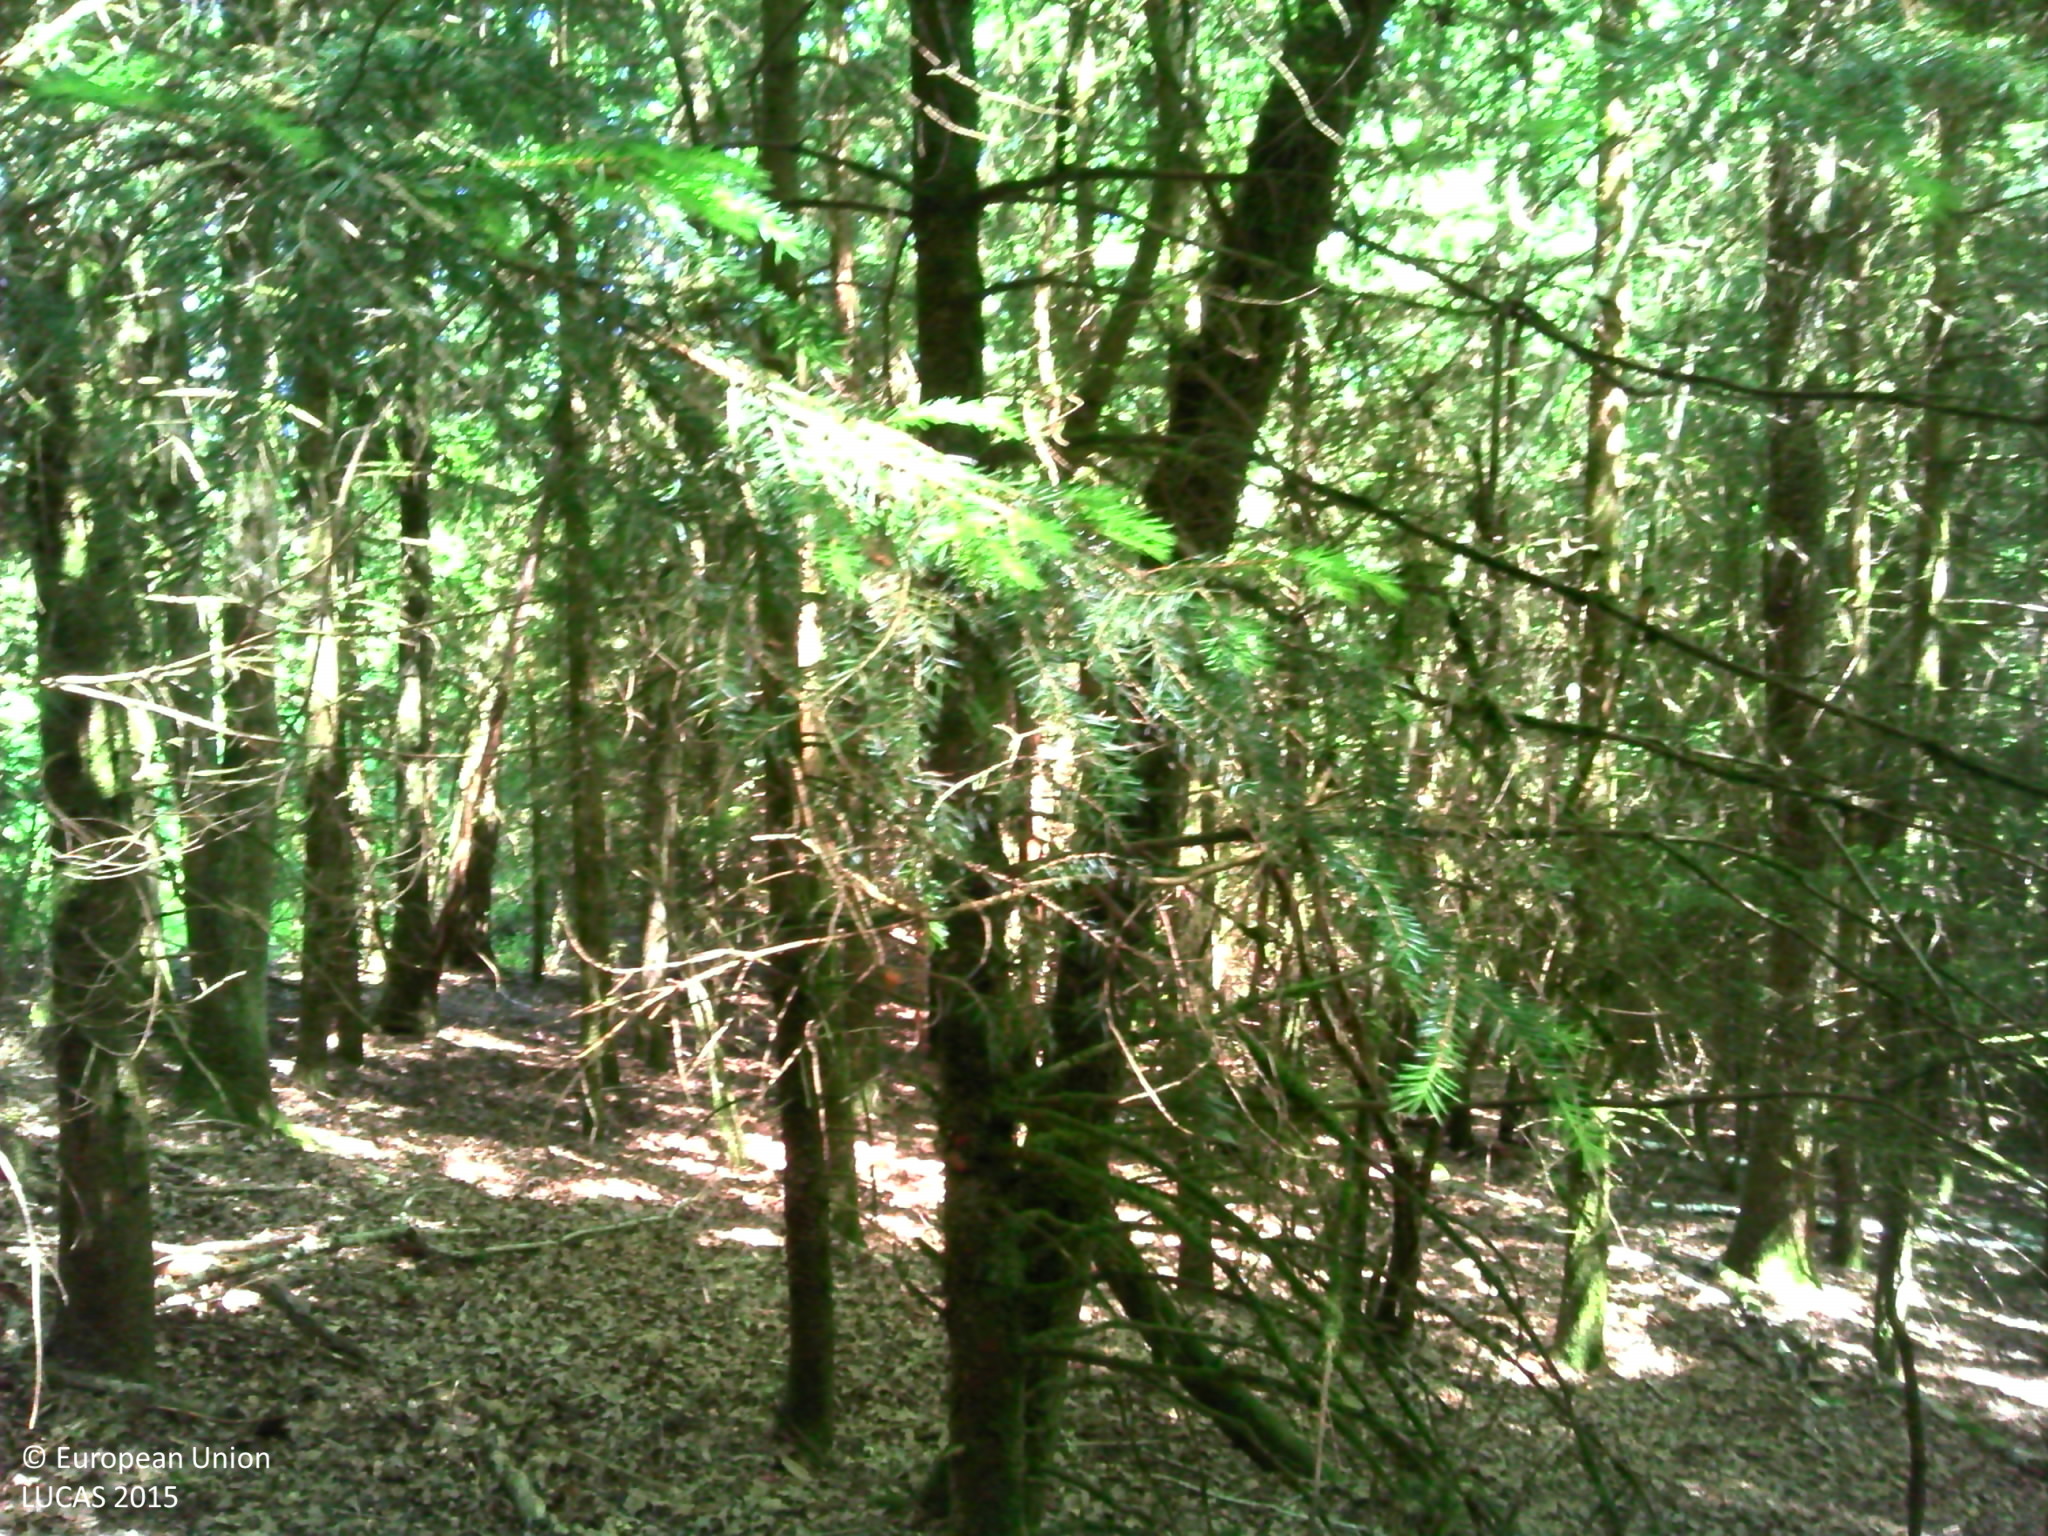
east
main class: Woodland
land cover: Spruce dominated mixed woodland
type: hemiboreal forest and nemoral coniferous forest and mixed broadleaved-coniferous forest
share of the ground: > 75 %
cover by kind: coniferous forest trees 50 %, broadleaved forest trees 20 %, shrubs 10 %, herbaceous plants 10 %, lichens and mosses 10 %
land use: Forestry
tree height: > 5 m
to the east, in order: Spruce dominated mixed woodland; Rivers and streams; Spruce dominated mixed woodland; Fences; Broadleaved woodland; Grassland without tree/shrub cover; Fences; Grassland without tree/shrub cover; Fences; Lines of trees; Ditches and canals; Paved roads, cycling and walking lanes; Electric lines; Spontaneously vegetated surfaces; Broadleaved woodland; Rivers and streams; Broadleaved woodland
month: June
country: FR
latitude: 45.3553
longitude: 2.3778
